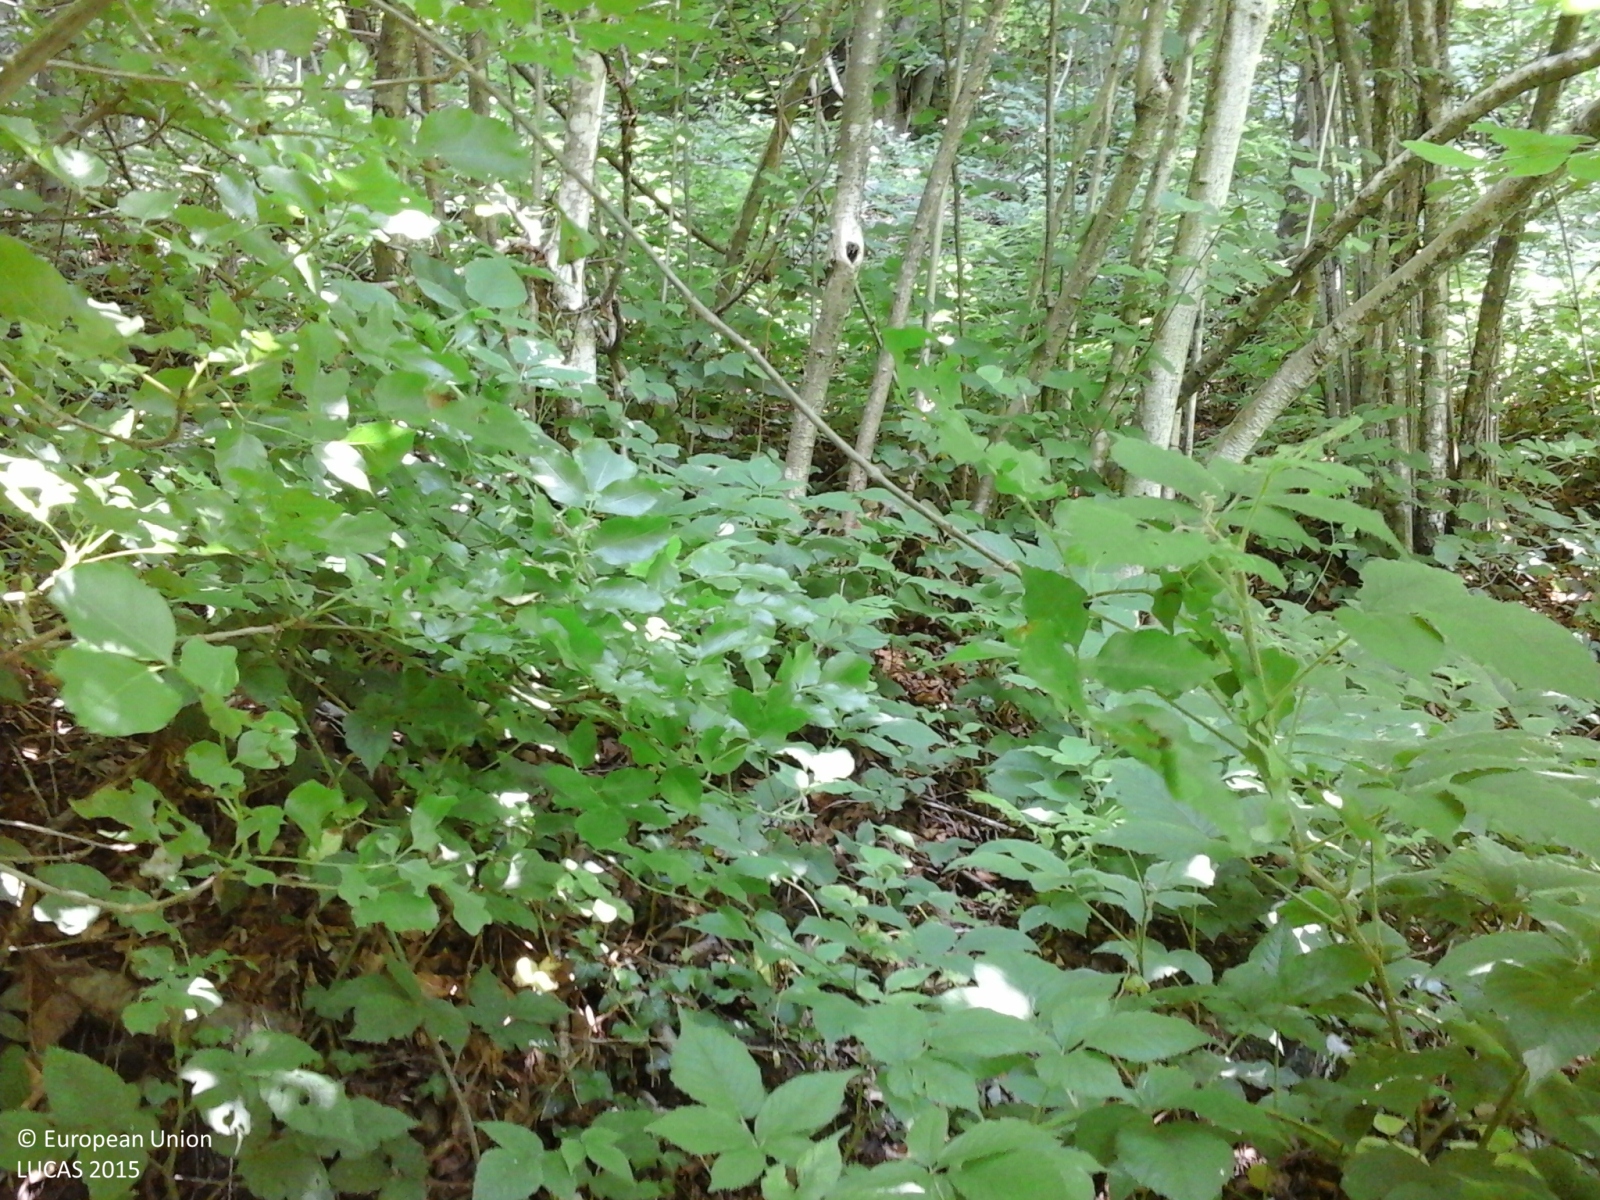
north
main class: Woodland
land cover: Broadleaved woodland
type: mesophytic deciduous forest
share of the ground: > 75 %
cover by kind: broadleaved forest trees 100 %
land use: Semi-natural and natural areas not in use
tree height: < 5 m
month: June
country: IT
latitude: 45.7387
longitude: 9.9615
